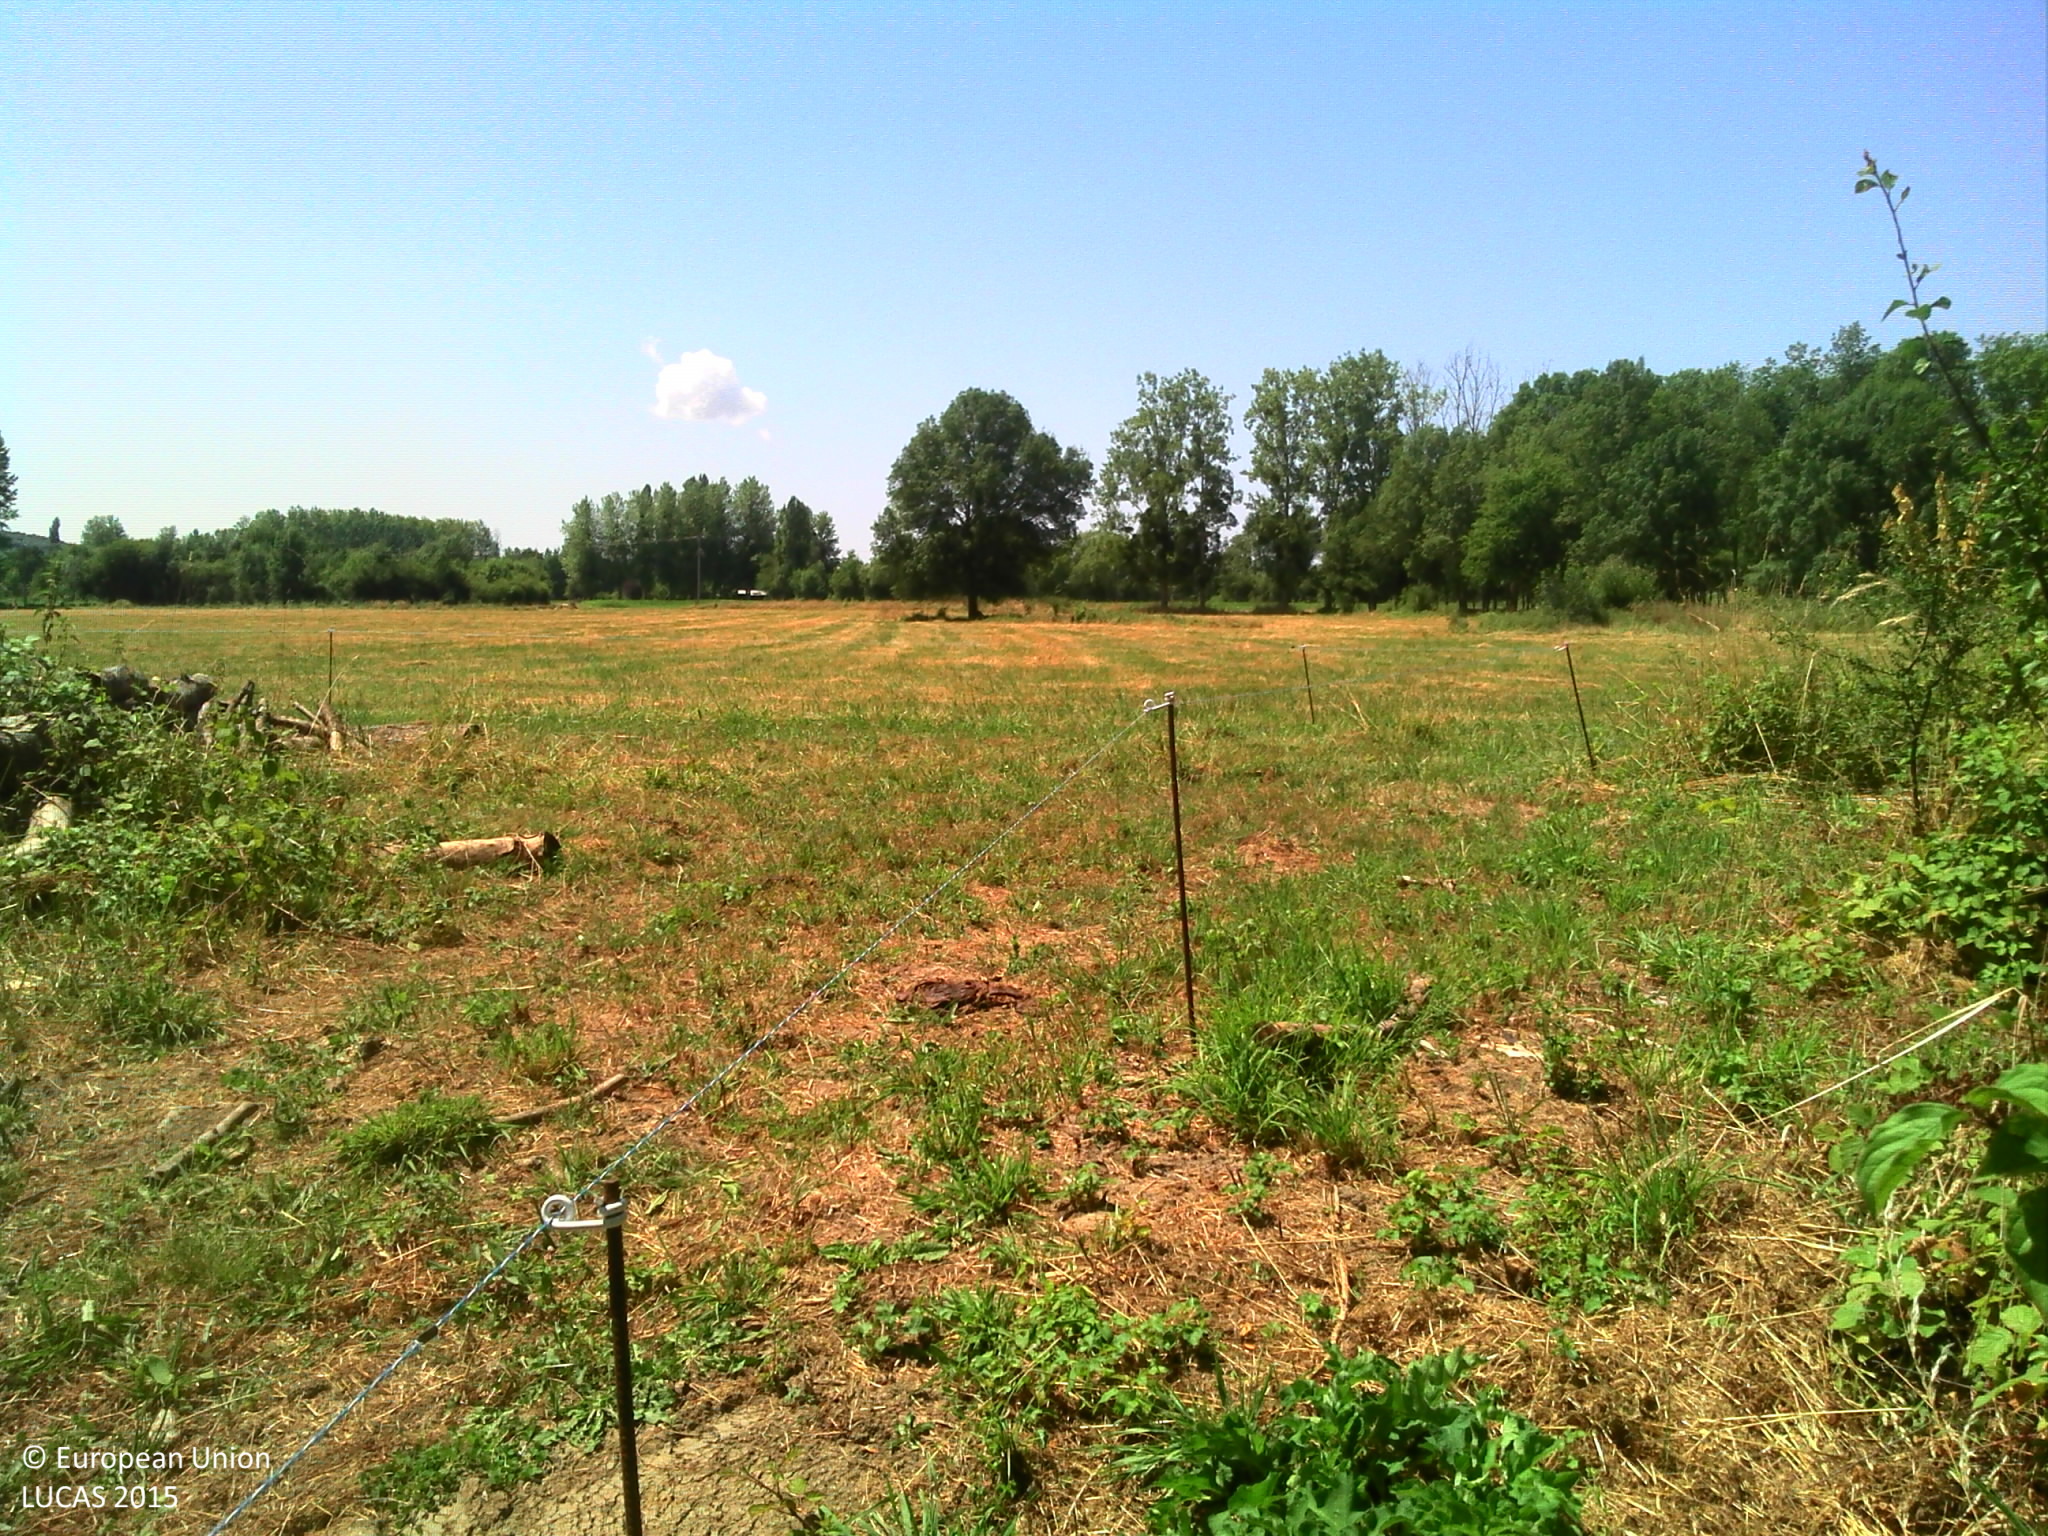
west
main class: Woodland
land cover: Broadleaved woodland
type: mesophytic deciduous forest
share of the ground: > 75 %
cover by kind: broadleaved forest trees 40 %, herbaceous plants 35 %, shrubs 20 %, lichens and mosses 5 %
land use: Forestry
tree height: > 5 m
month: July
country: FR
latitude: 47.2730
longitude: 0.3418
